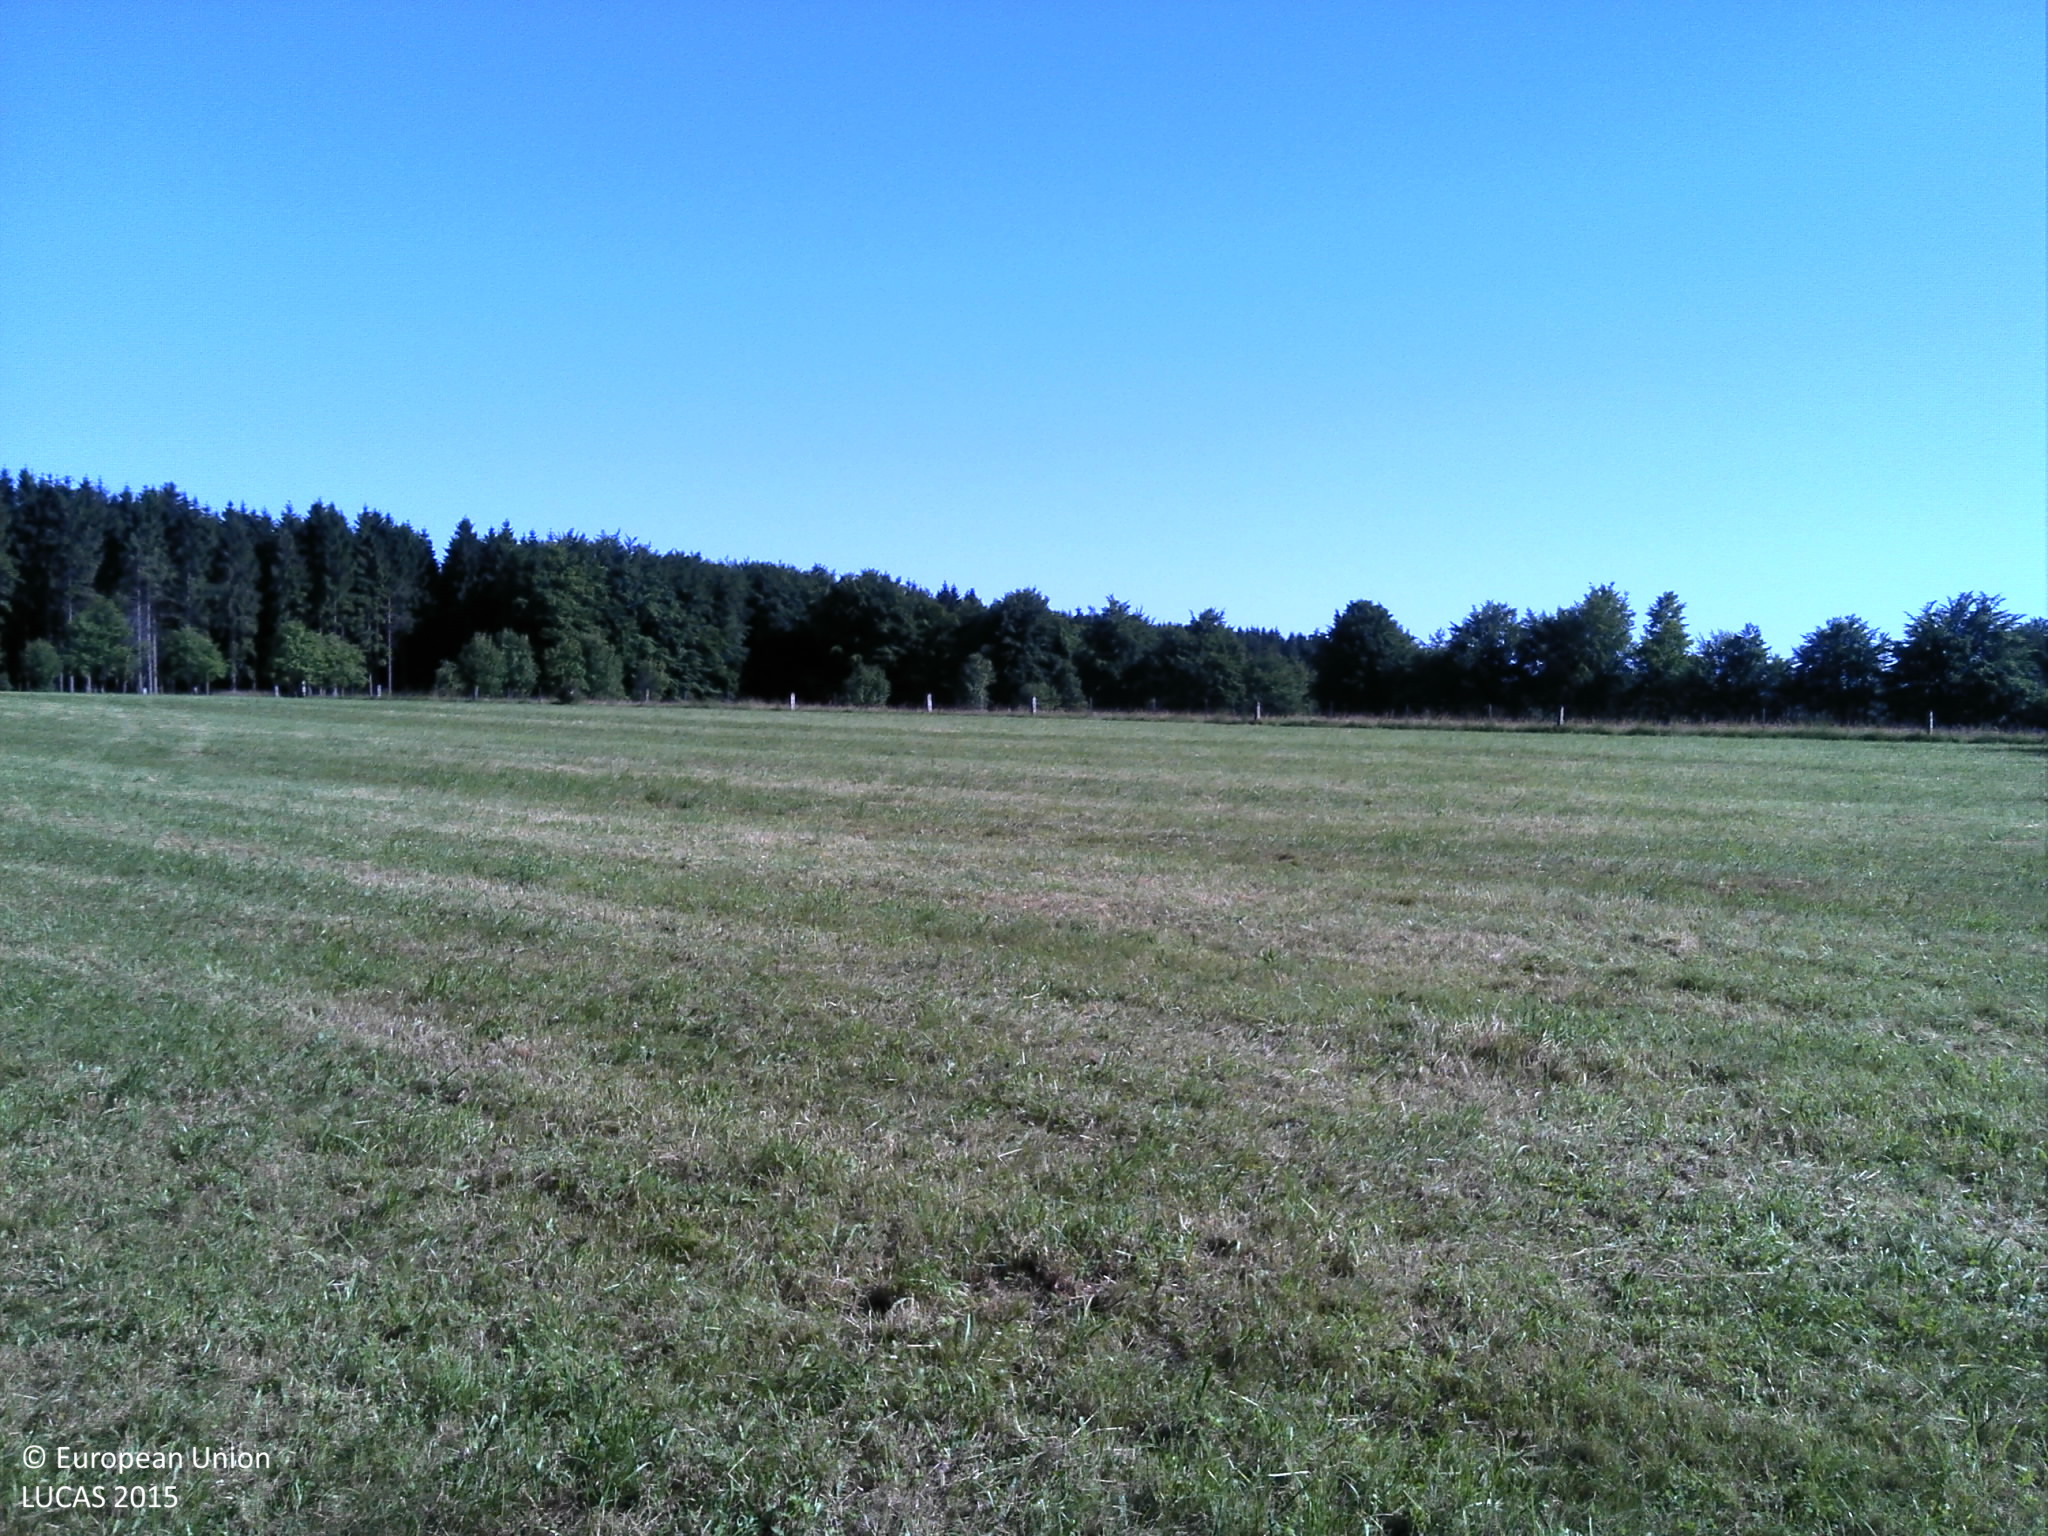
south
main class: Grassland
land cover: Grassland without tree/shrub cover
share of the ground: > 75 %
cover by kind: herbaceous plants 100 %
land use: Agriculture (excluding fallow land and kitchen gardens)
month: June
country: FR
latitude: 49.9574
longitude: 4.7977
